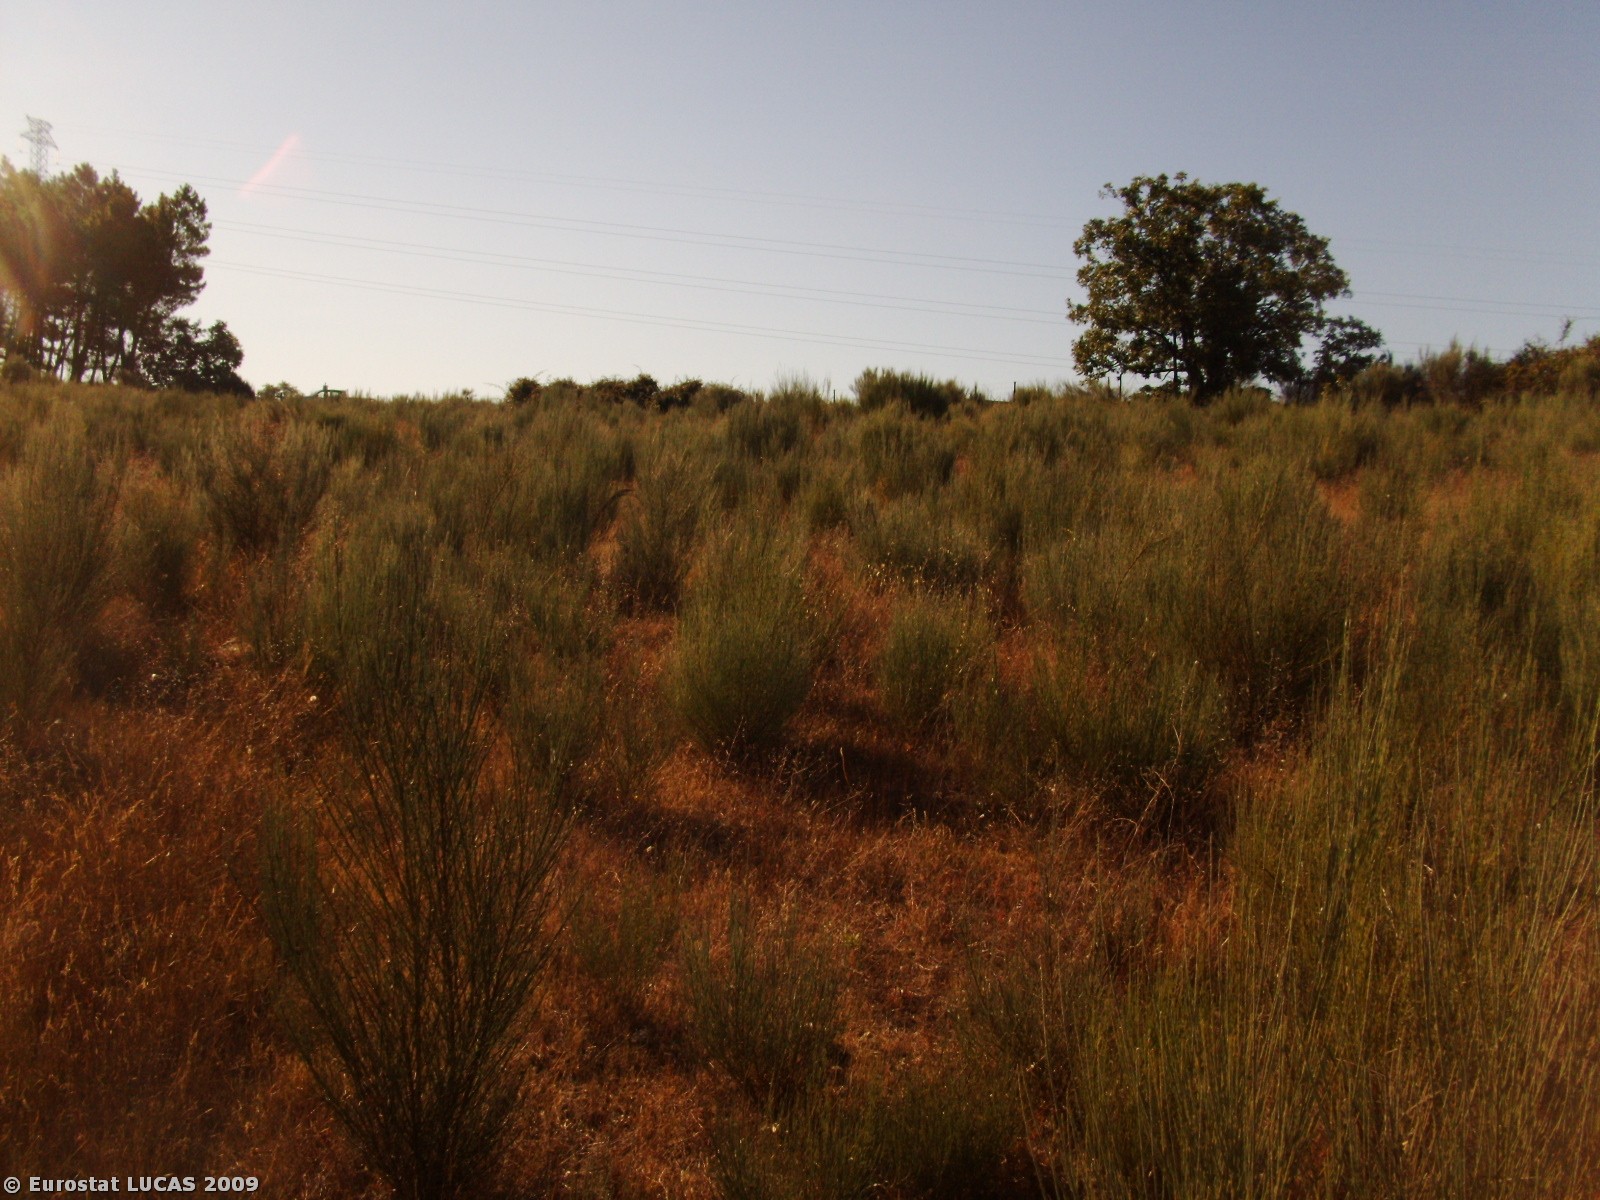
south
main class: Shrubland
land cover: Shrubland with sparse tree cover
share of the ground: > 75 %
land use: Fallow land
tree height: > 5 m
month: July
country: PT
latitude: 40.3064
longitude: -7.3892
